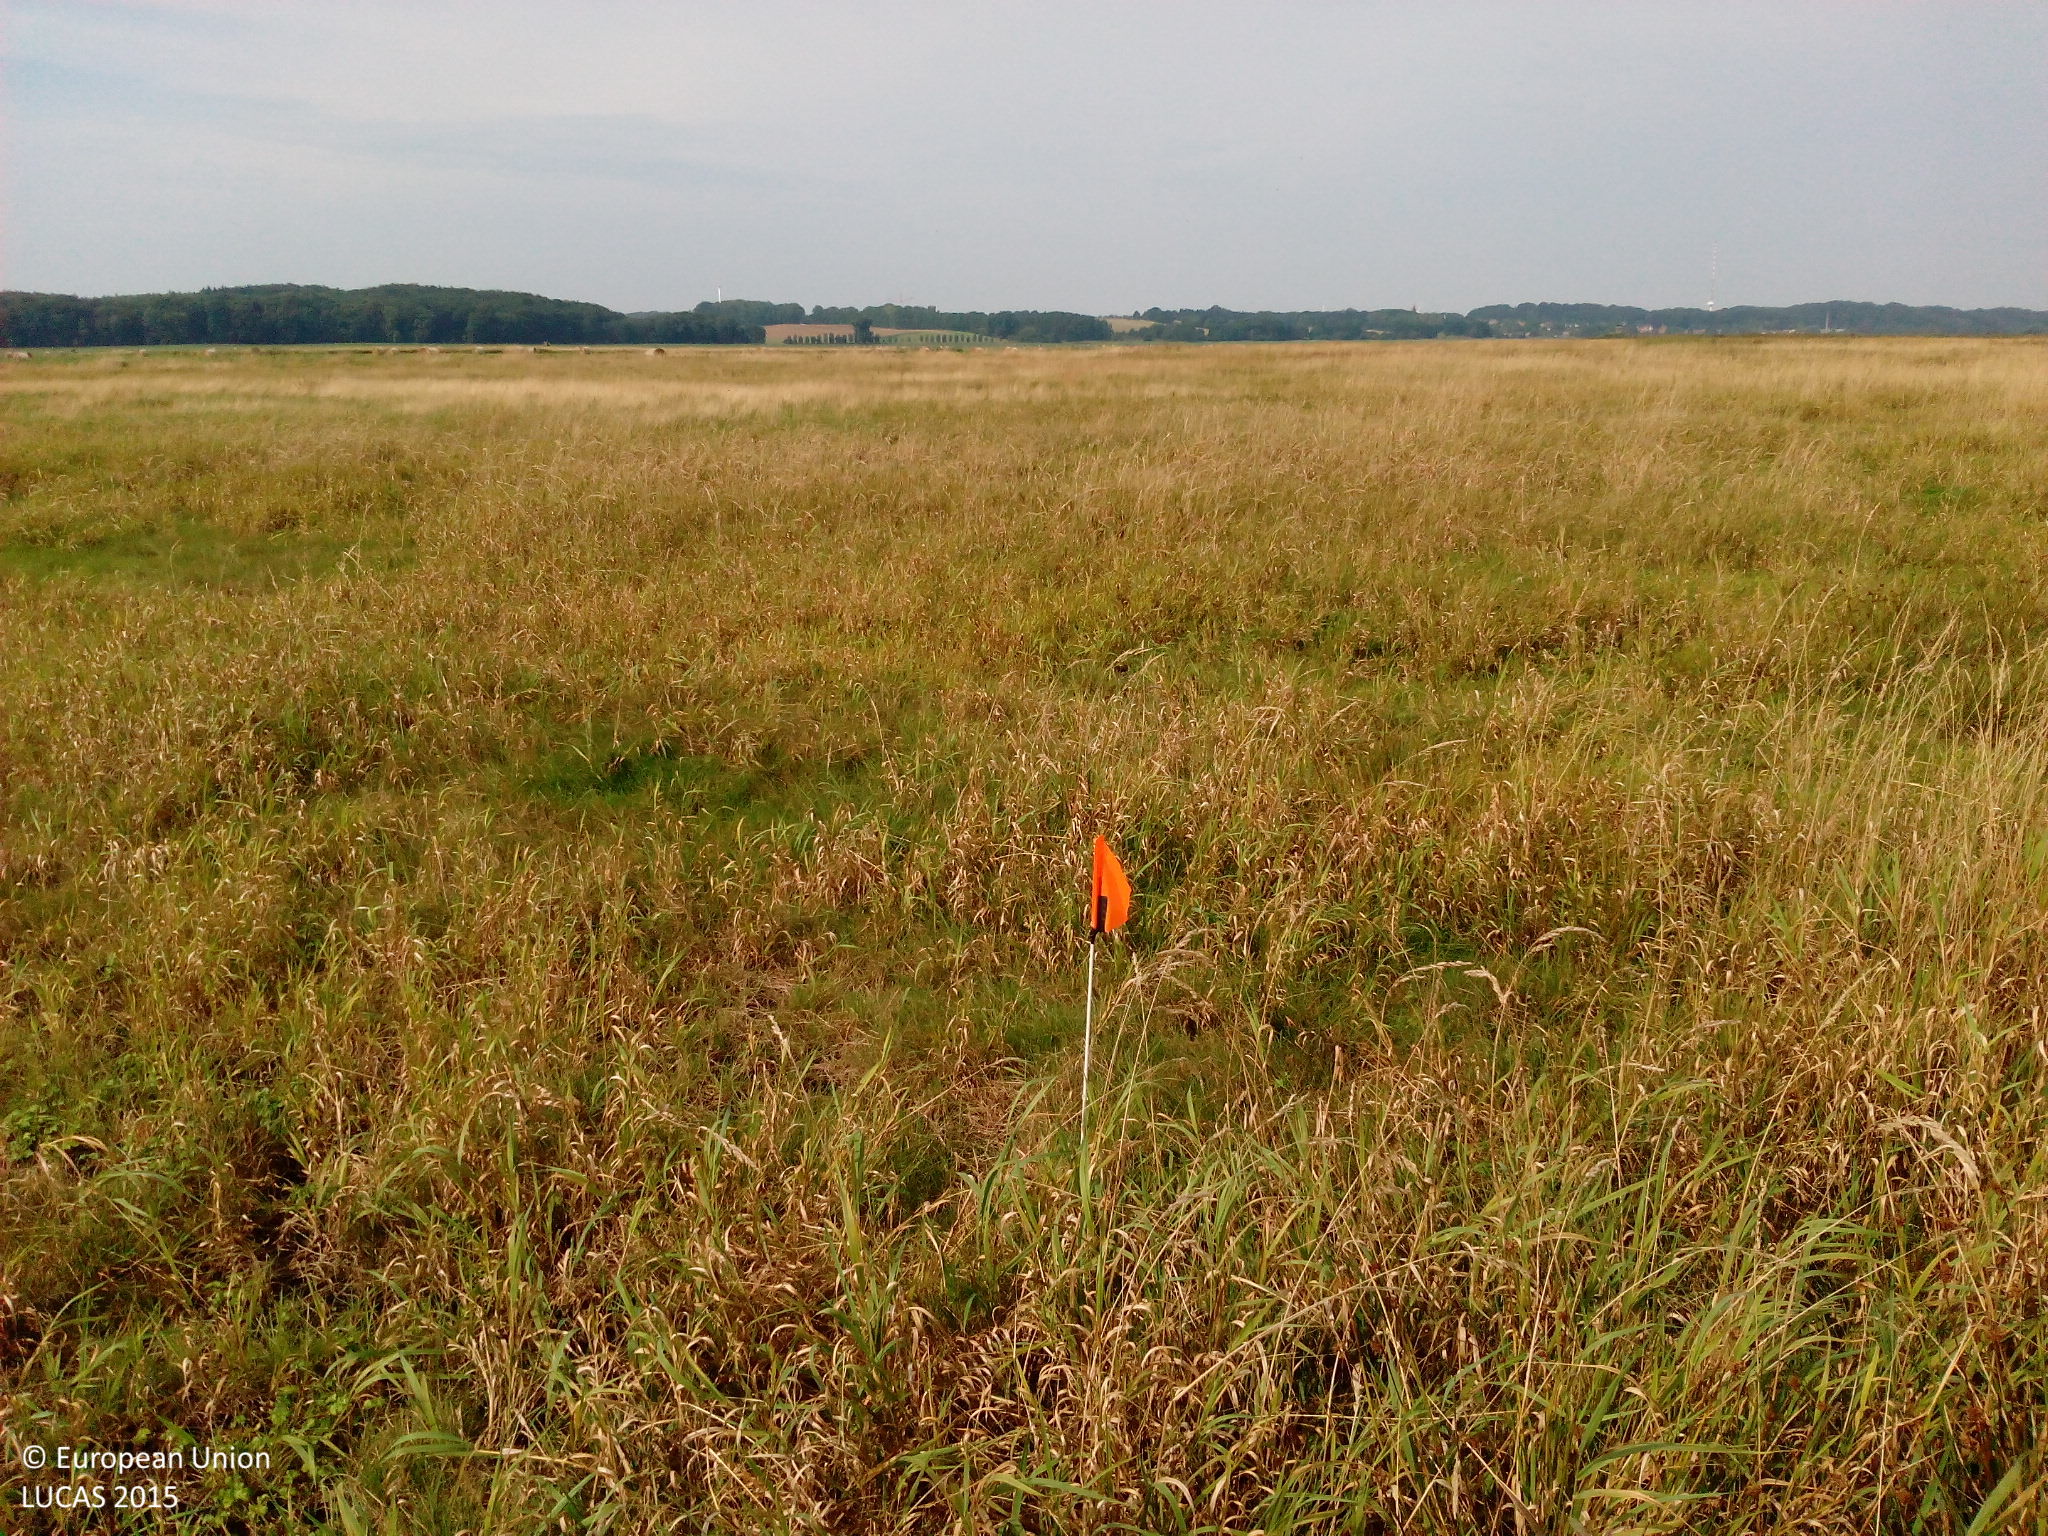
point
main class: Grassland
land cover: Grassland without tree/shrub cover
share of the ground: > 75 %
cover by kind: herbaceous plants 100 %
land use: Agriculture (excluding fallow land and kitchen gardens)
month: August
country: DE
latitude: 54.1469
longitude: 12.6170
